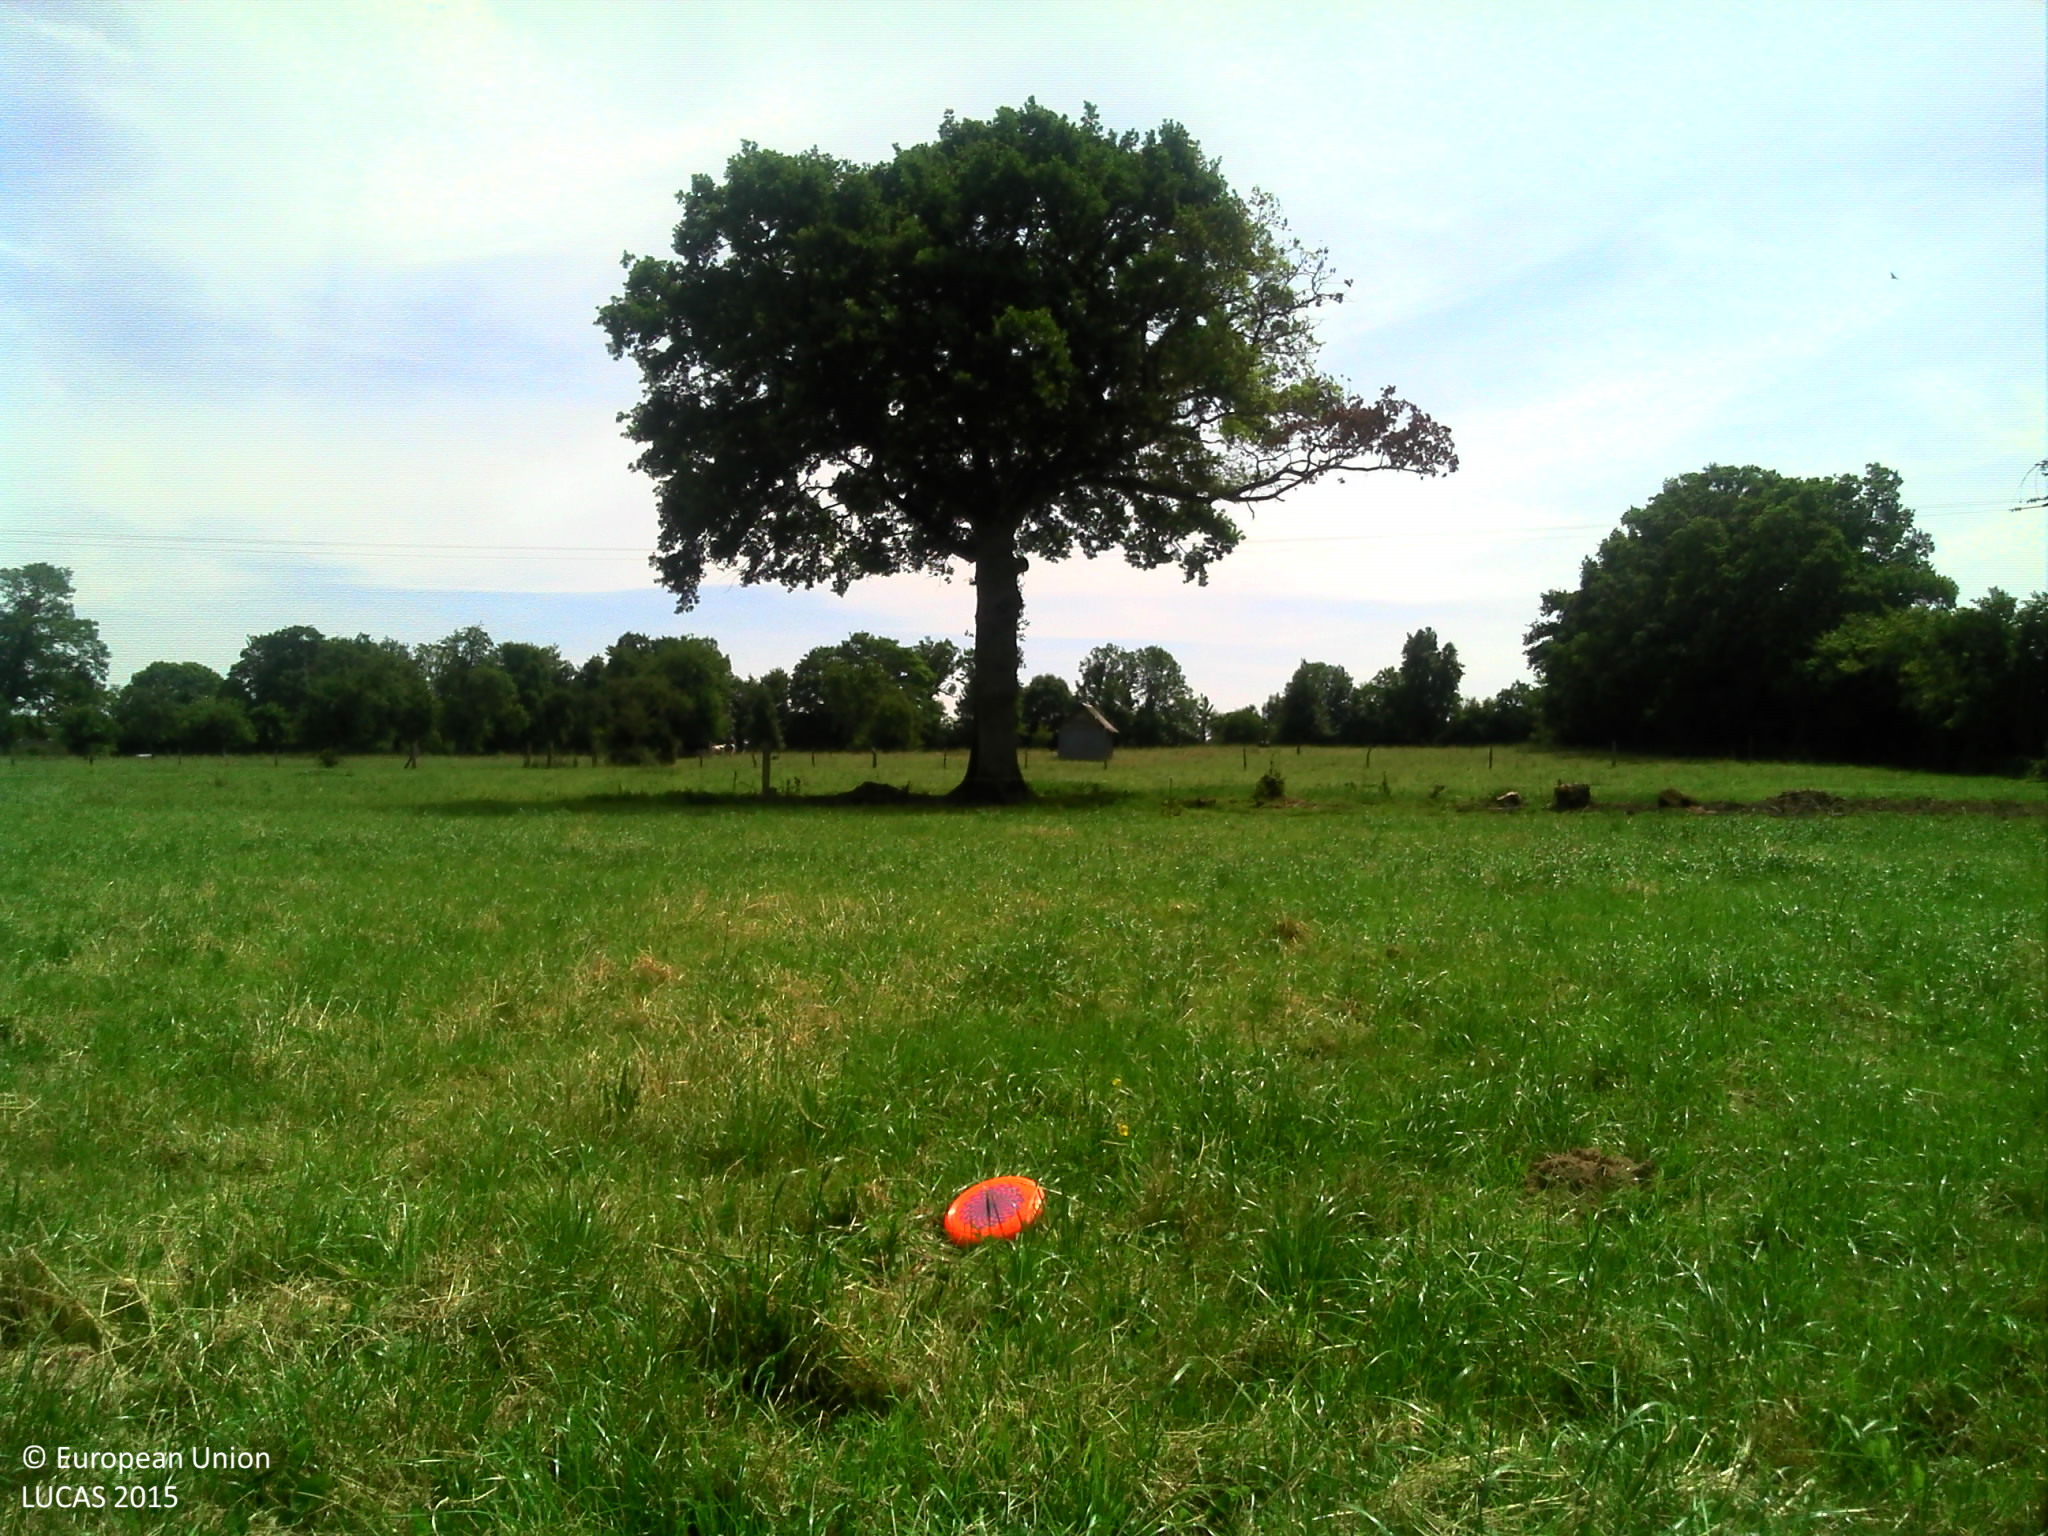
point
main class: Grassland
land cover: Grassland without tree/shrub cover
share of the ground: > 75 %
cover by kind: herbaceous plants 100 %
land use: Agriculture (excluding fallow land and kitchen gardens)
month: June
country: FR
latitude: 48.7958
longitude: -0.2564
